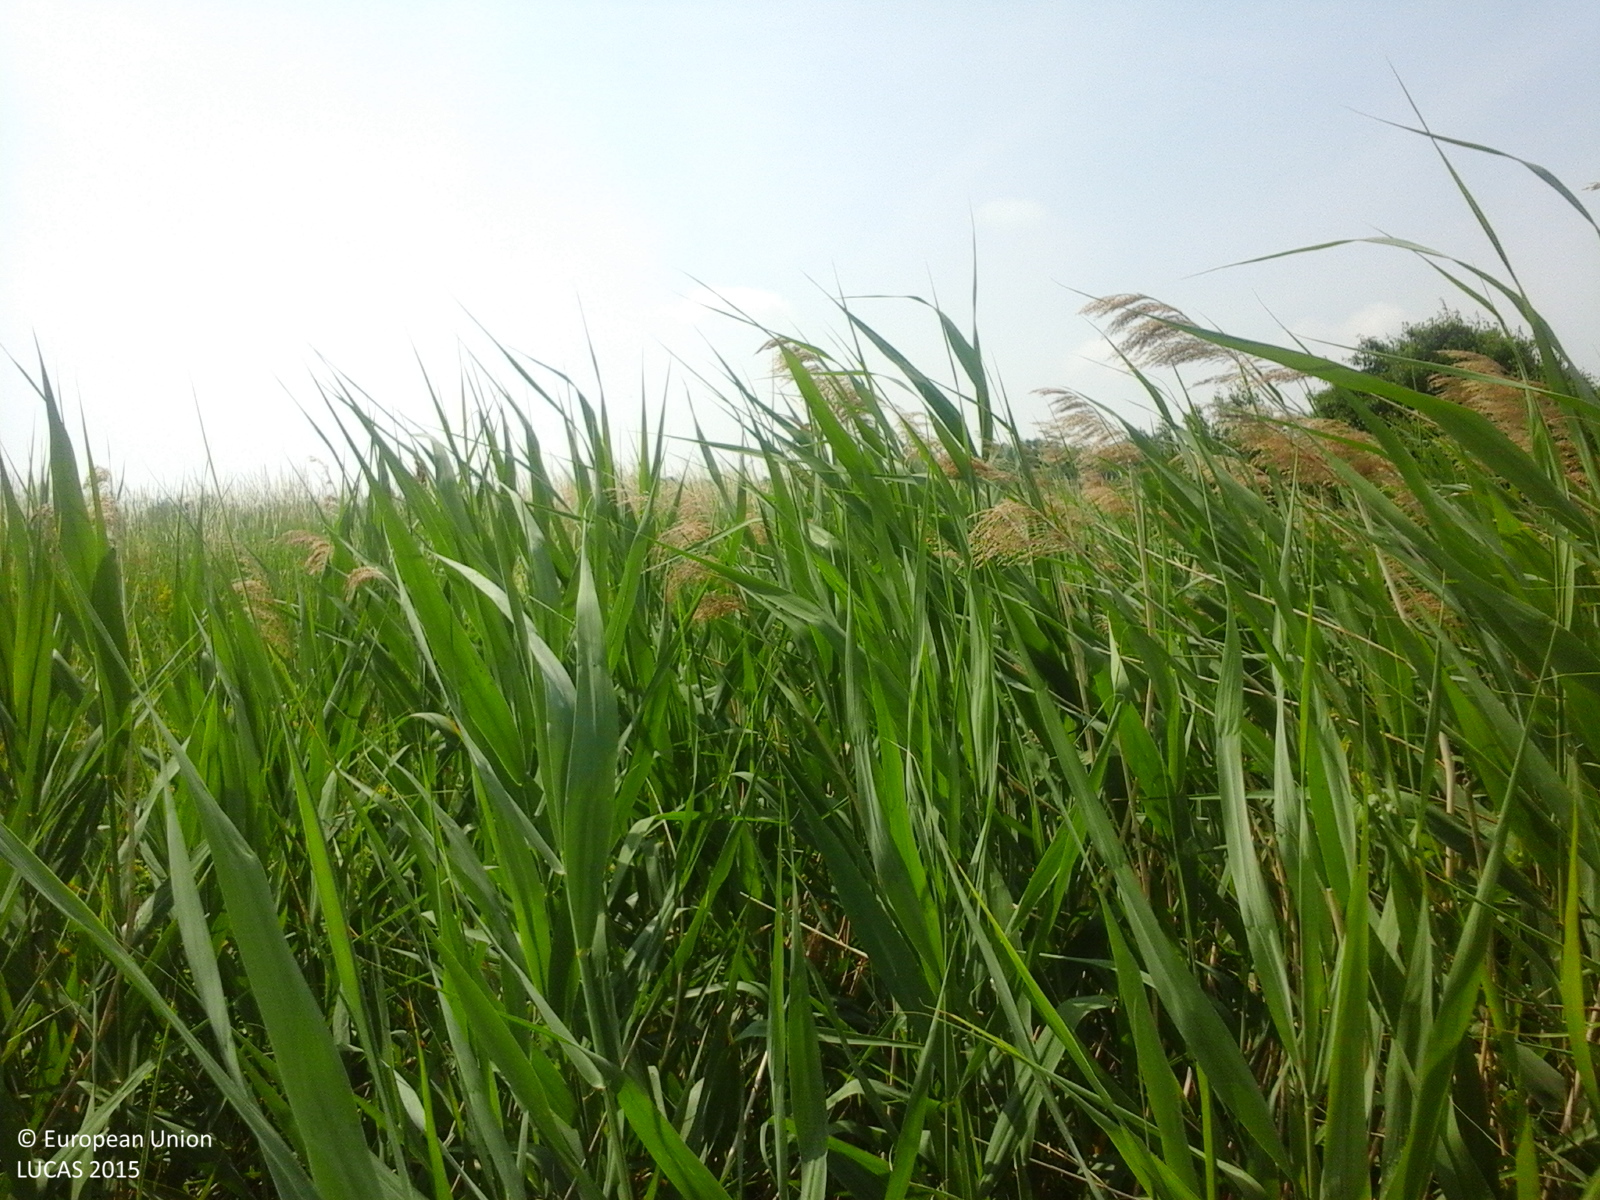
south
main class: Grassland
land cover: Spontaneously vegetated surfaces
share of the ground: > 75 %
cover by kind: herbaceous plants 100 %
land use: Fallow land
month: June
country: RO
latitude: 47.6568
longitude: 26.9184
